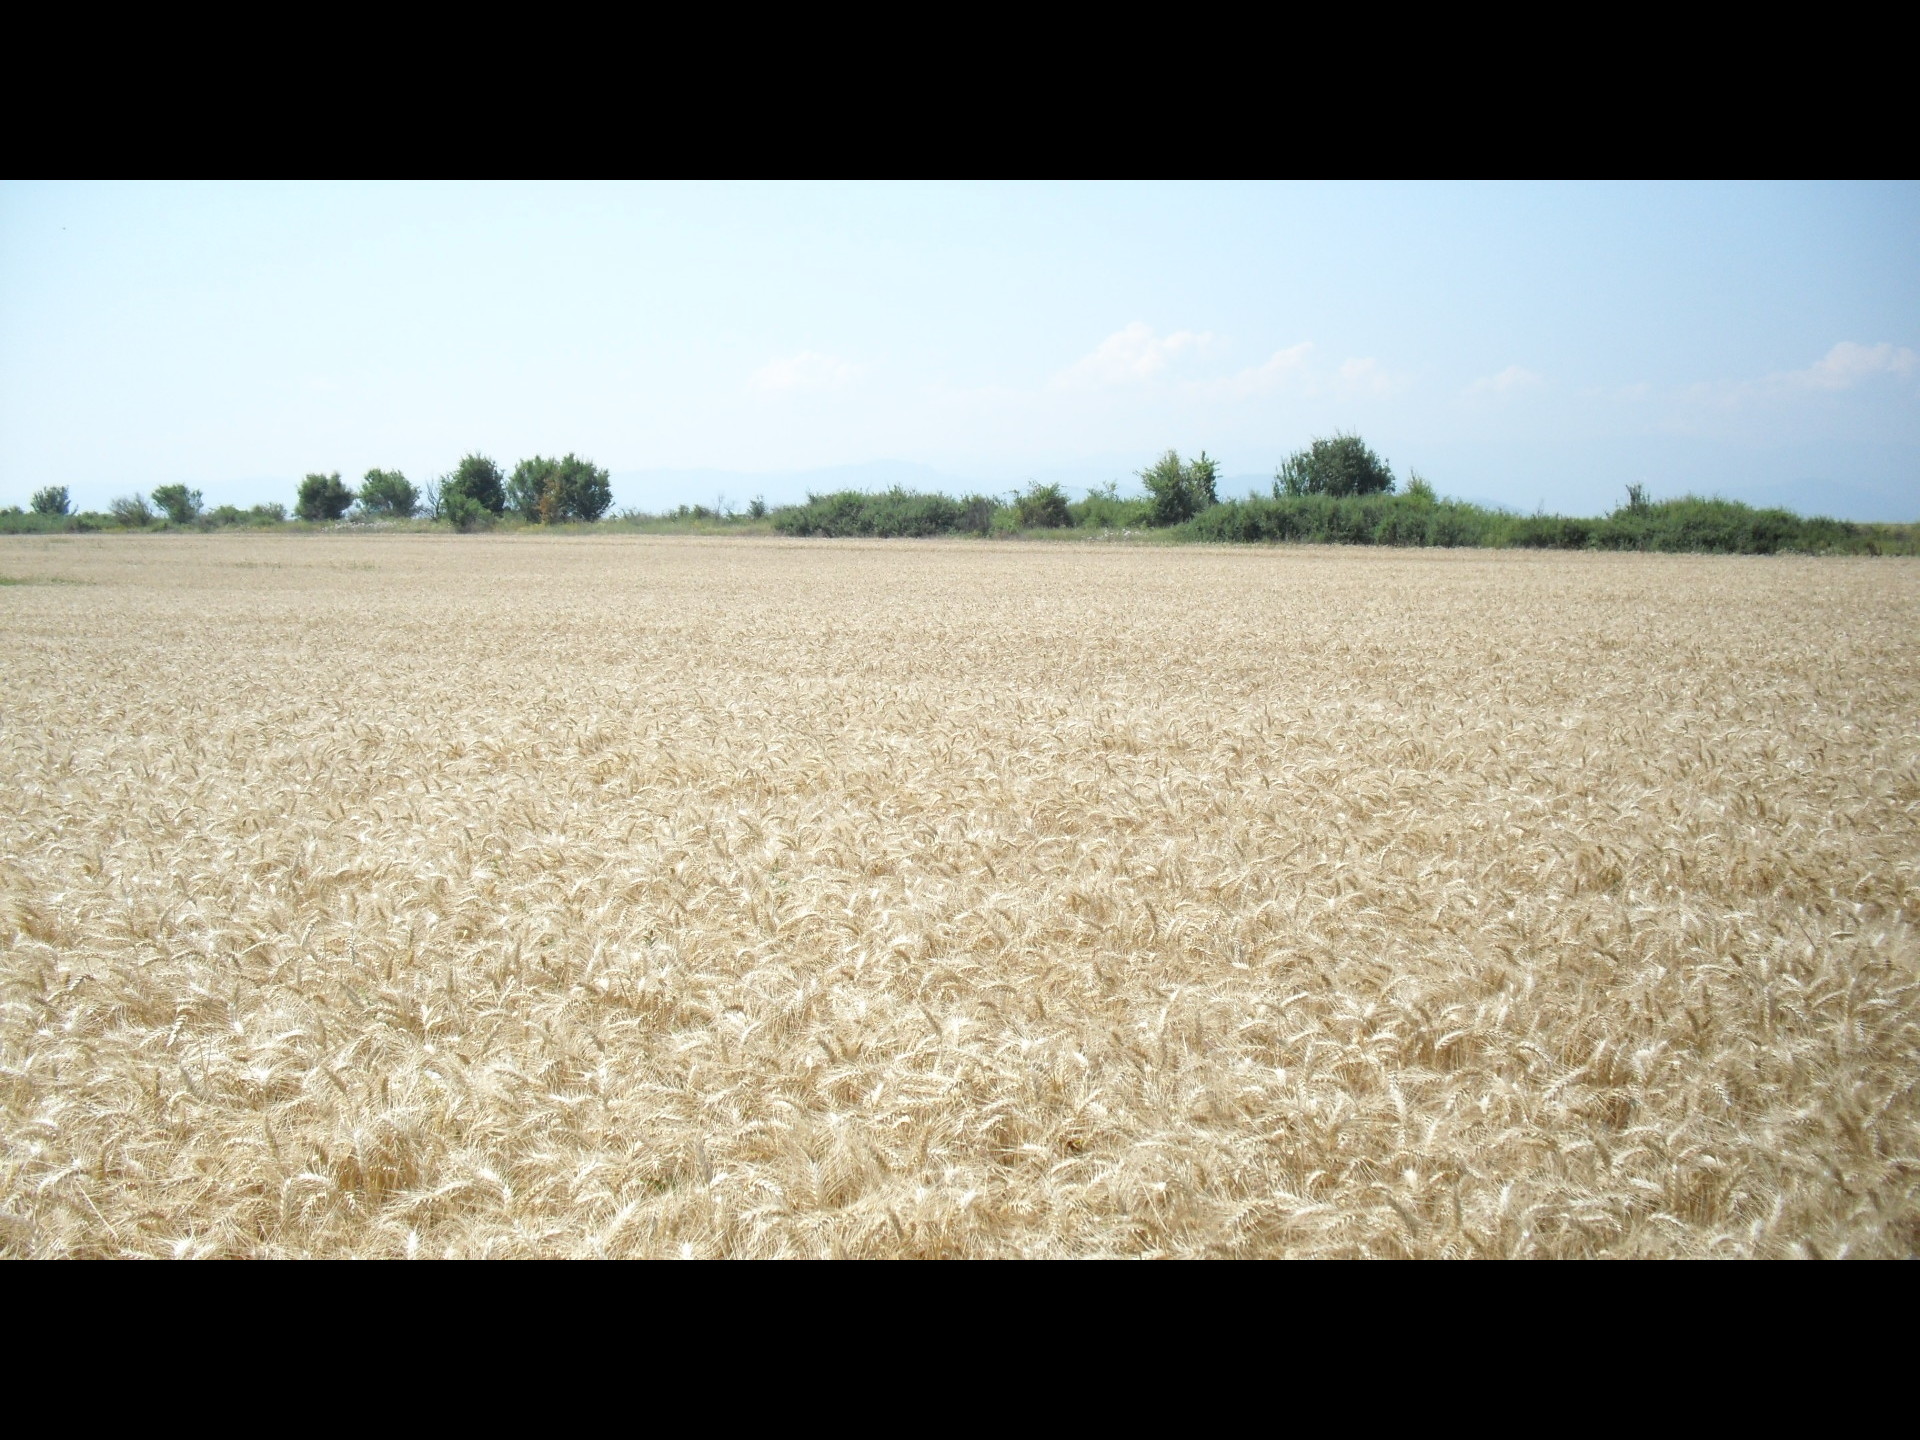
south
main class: Cropland
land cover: Common wheat
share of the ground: > 75 %
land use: Agriculture (excluding fallow land and kitchen gardens)
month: July
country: BG
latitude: 43.6873
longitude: 22.9023
